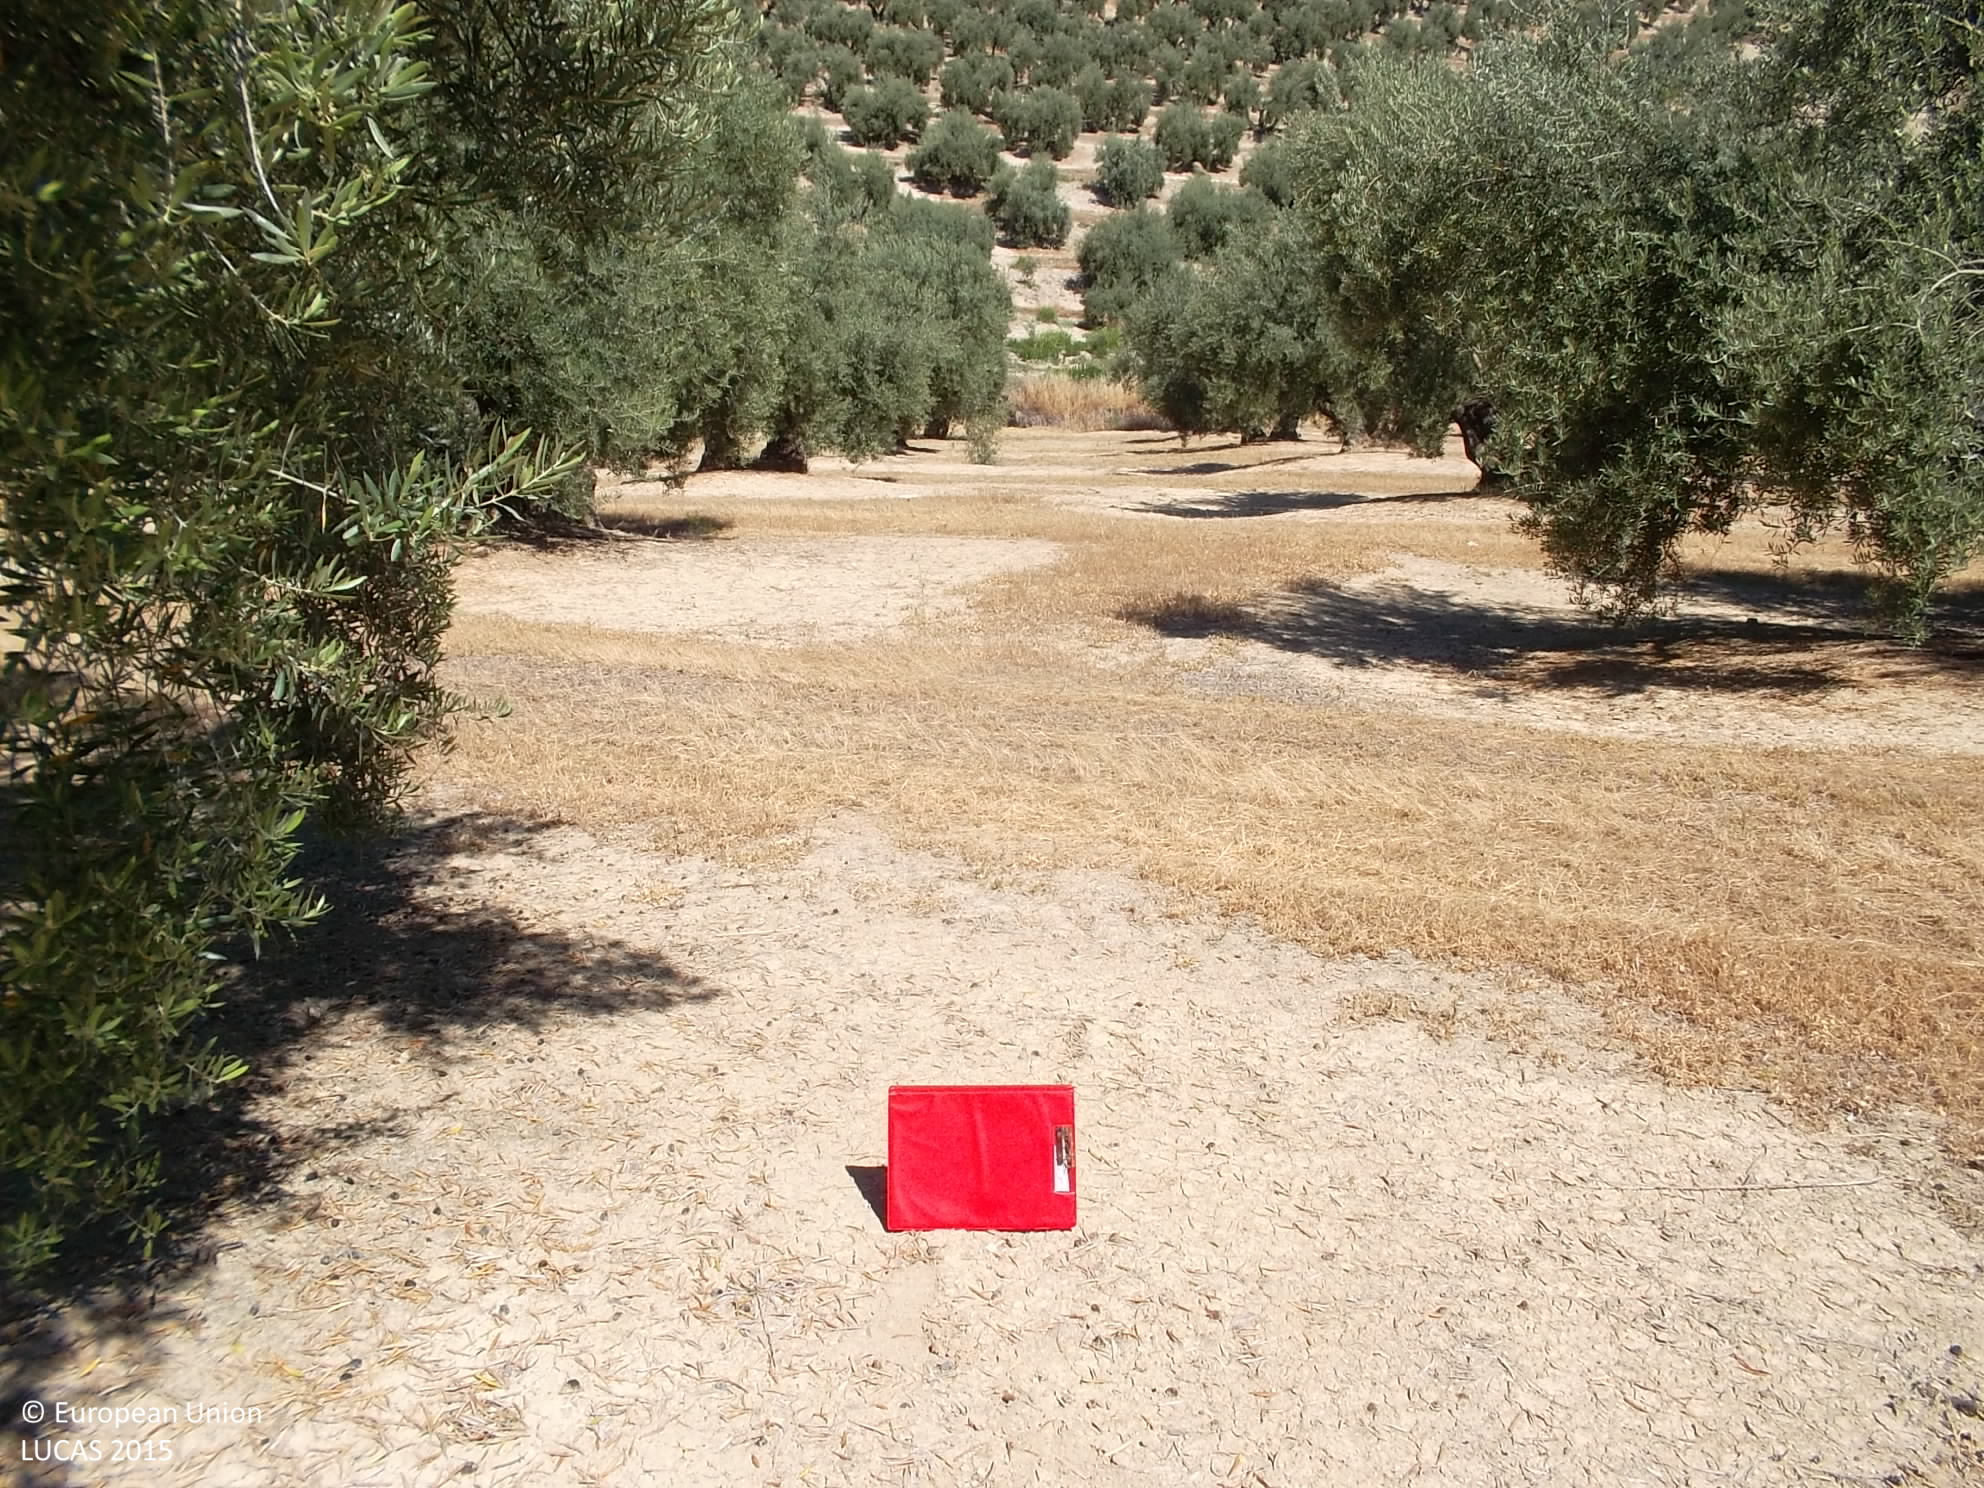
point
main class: Cropland
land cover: Olive groves
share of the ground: 50 - 75 %
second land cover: Other bare soil
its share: > 75 %
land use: Agriculture (excluding fallow land and kitchen gardens)
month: June
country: ES
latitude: 37.9447
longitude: -3.0482
